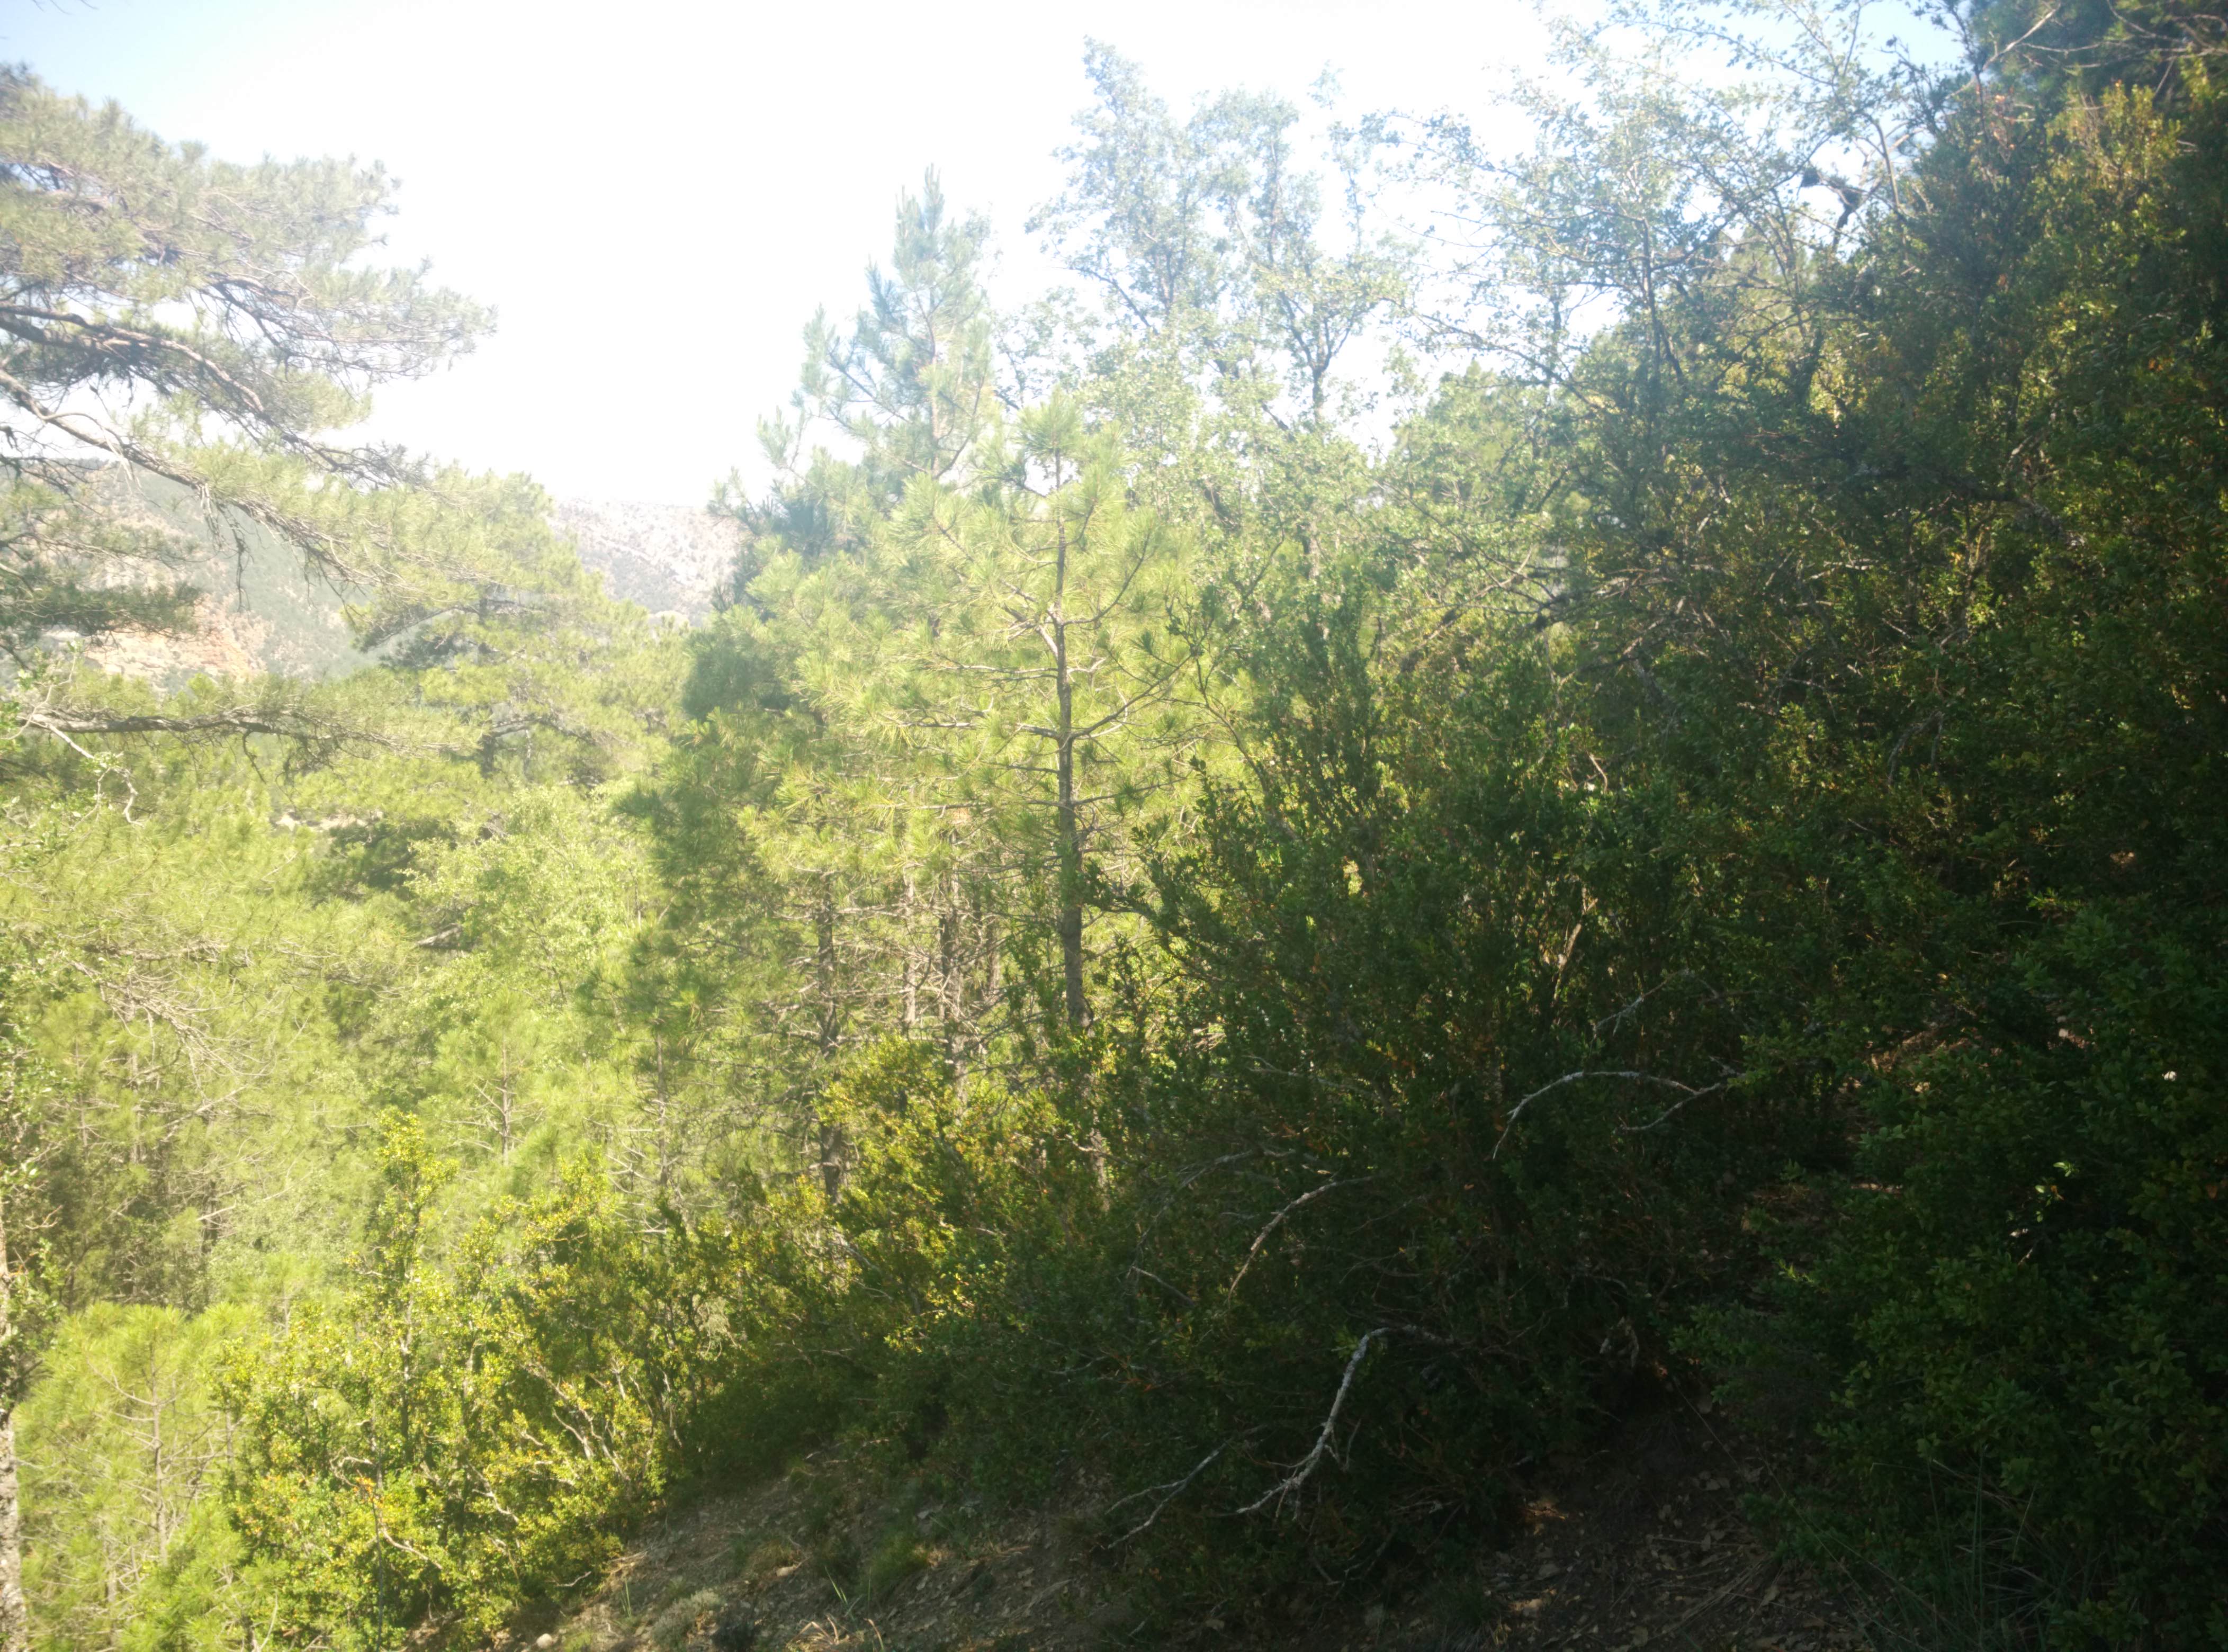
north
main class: Woodland
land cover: Pine dominated mixed woodland
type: coniferous forest of the mediterranean region
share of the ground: 50 - 75 %
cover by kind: coniferous forest trees 40 %, unconsolidated bare surface 25 %, broadleaved forest trees 20 %, shrubs 10 %, herbaceous plants 5 %
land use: Semi-natural and natural areas not in use
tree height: > 5 m
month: June
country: ES
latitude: 40.6629
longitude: -1.9796
